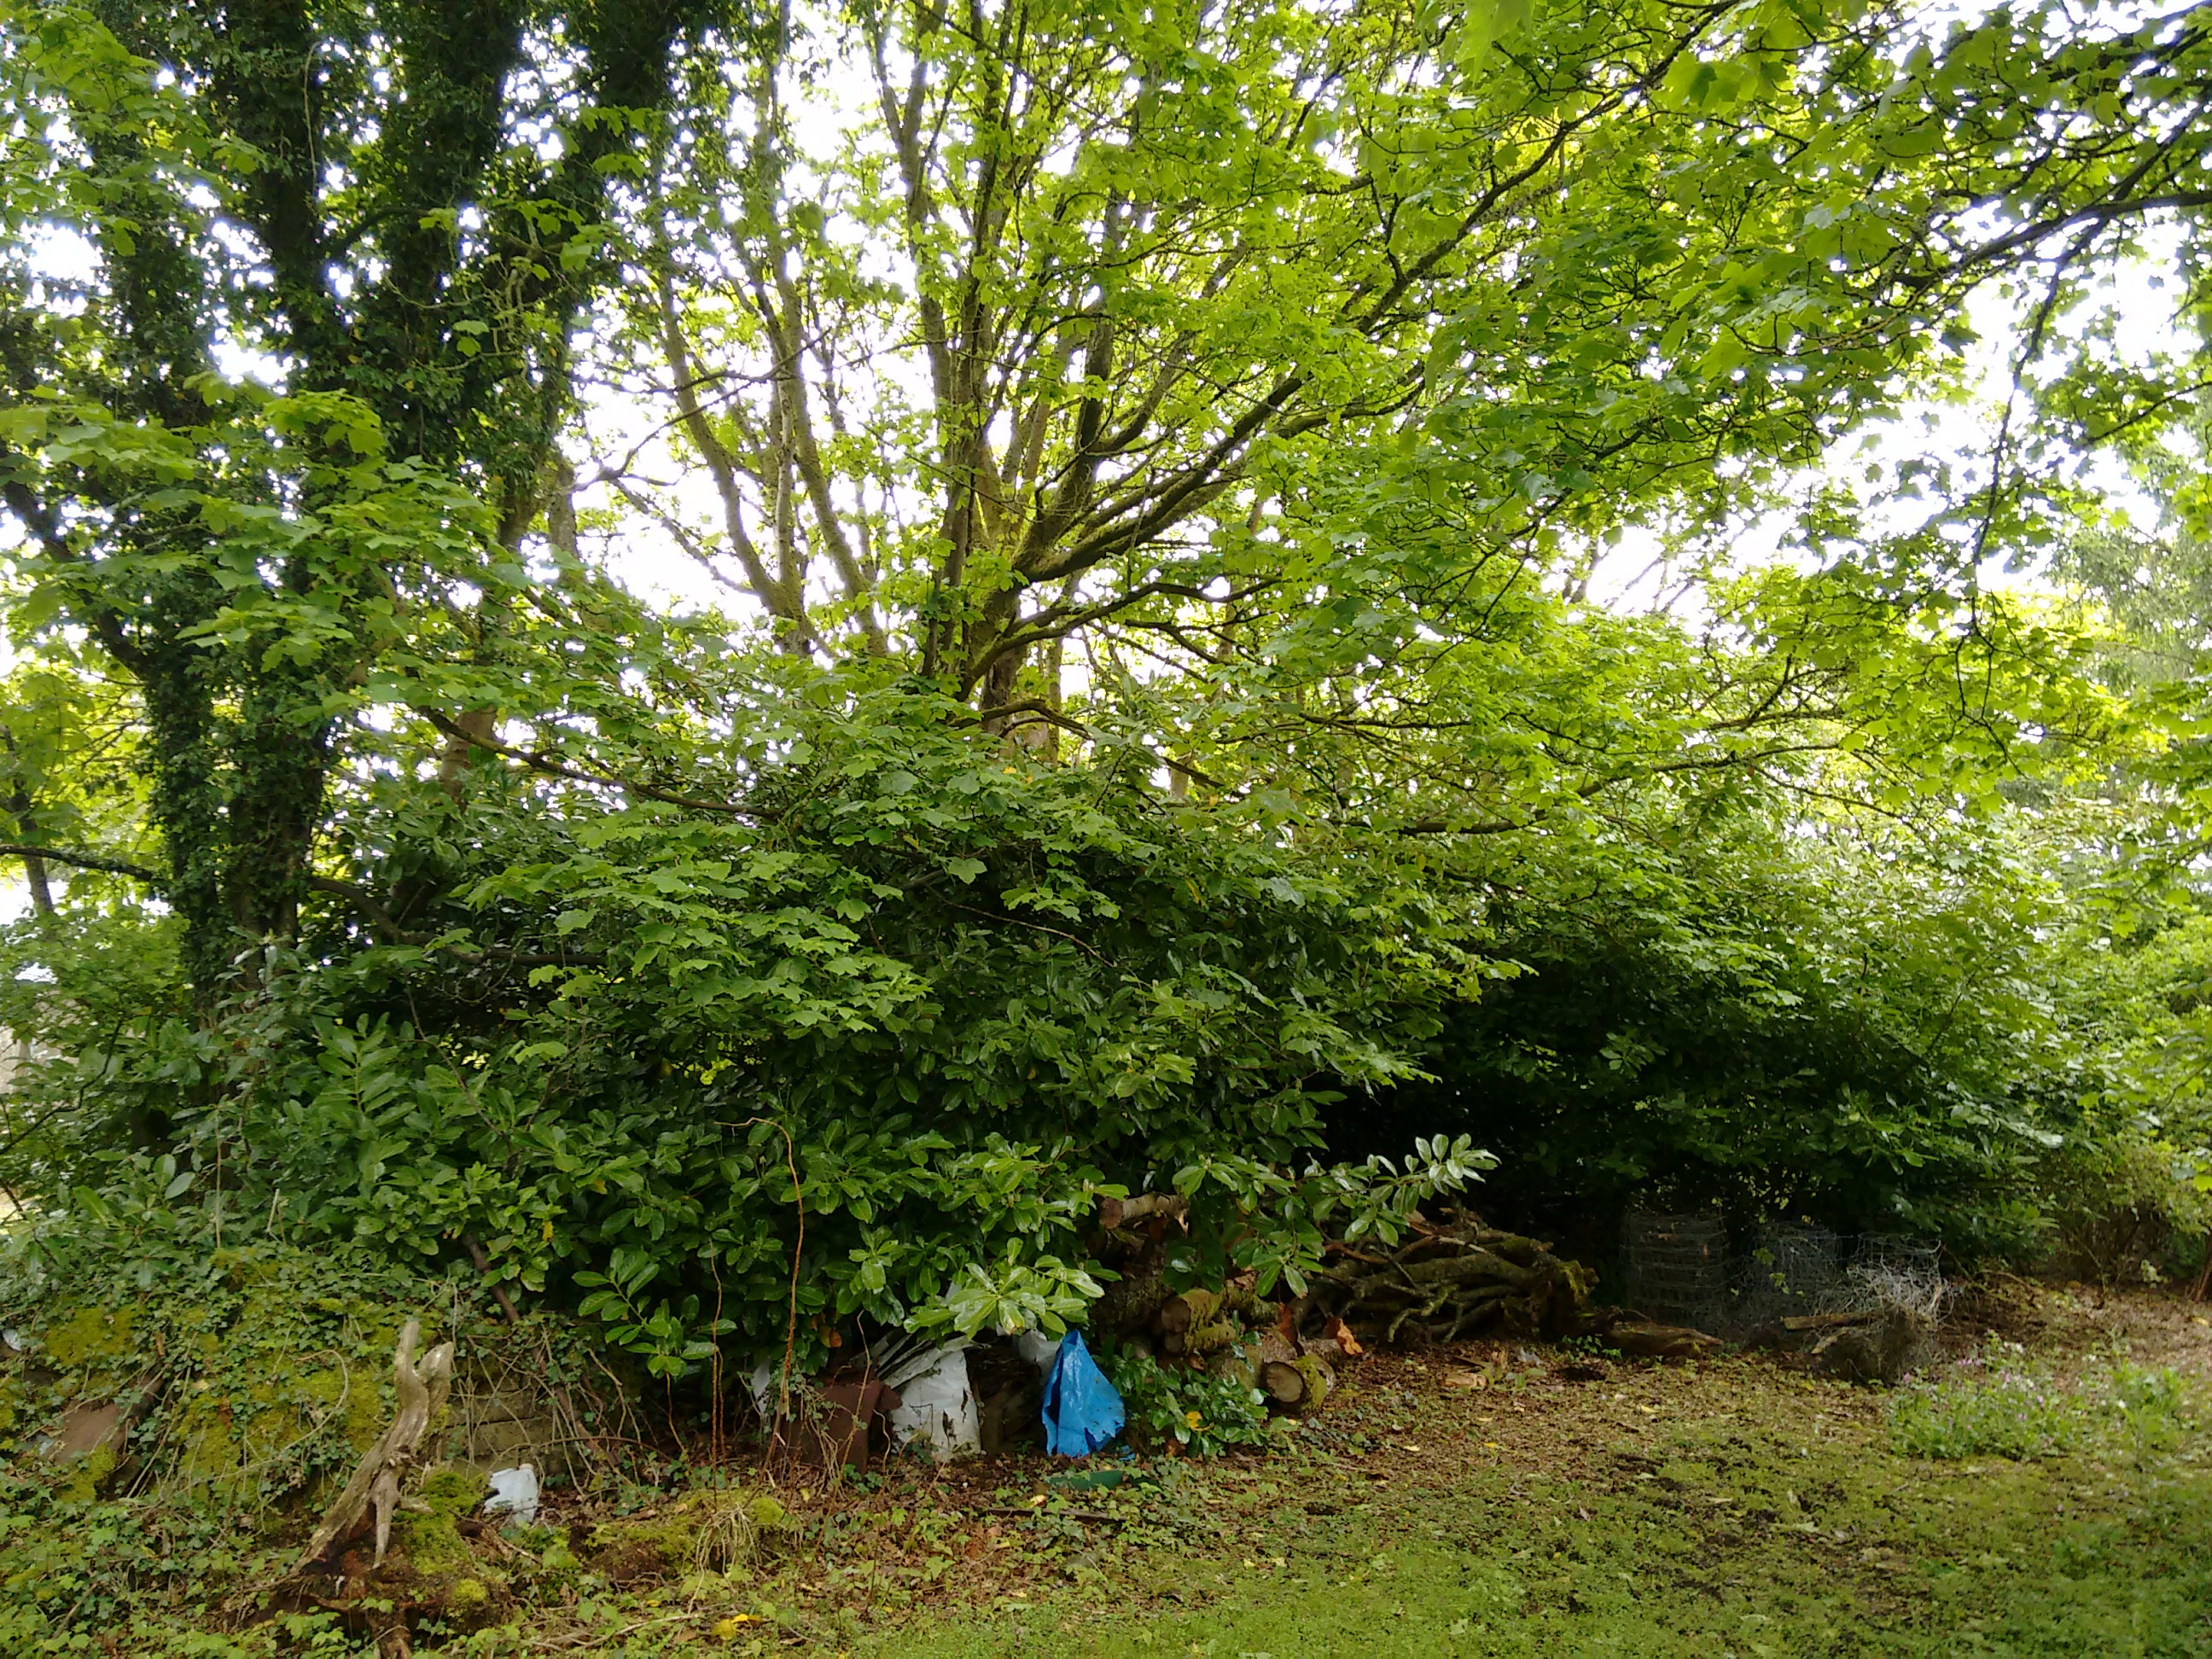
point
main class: Woodland
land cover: Broadleaved woodland
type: mesophytic deciduous forest
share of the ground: > 75 %
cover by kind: broadleaved forest trees 100 %
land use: Semi-natural and natural areas not in use
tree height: > 5 m
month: June
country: GB
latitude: 54.9894
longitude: -6.9692
